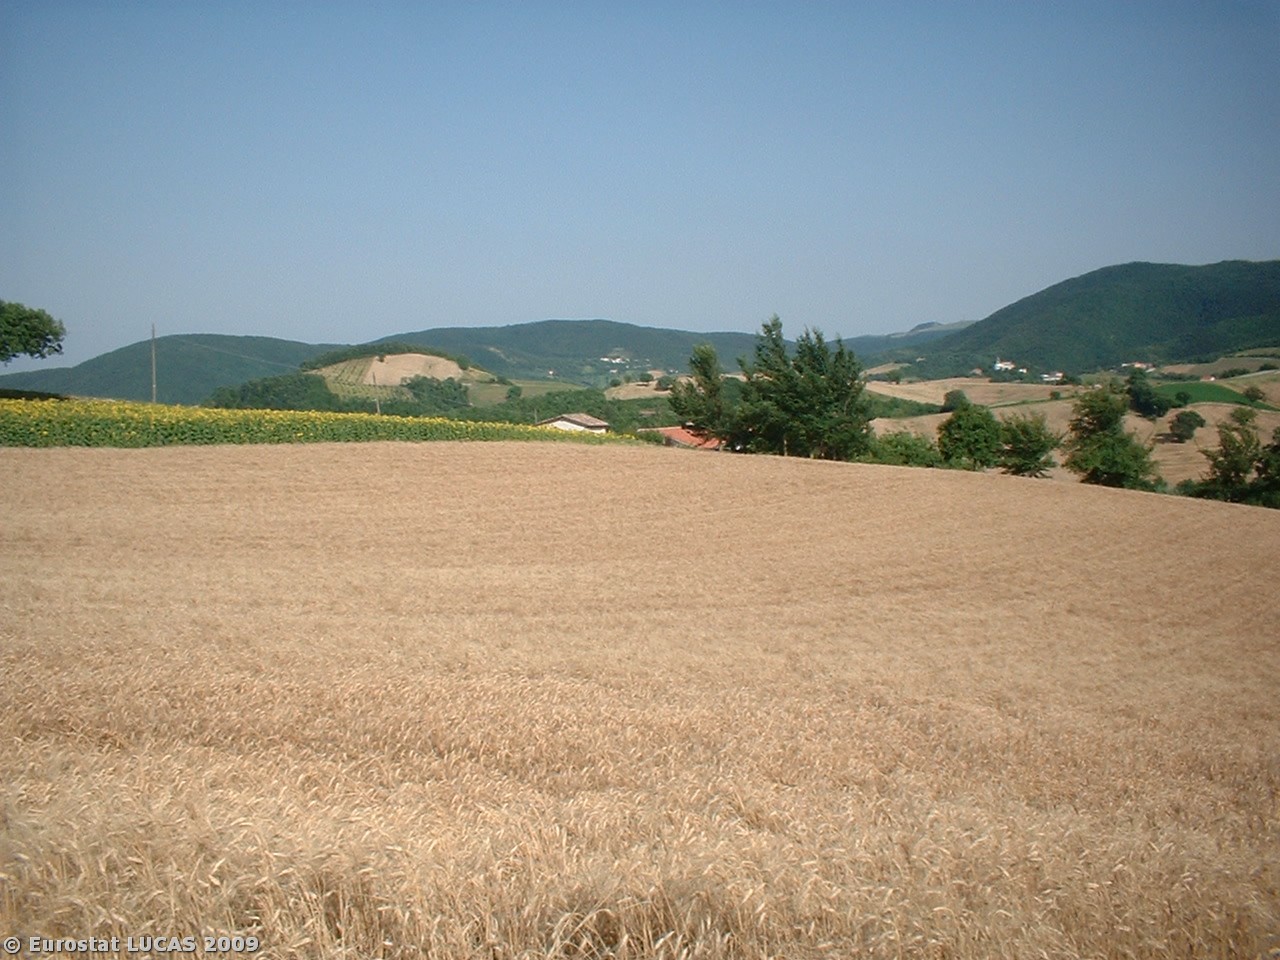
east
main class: Cropland
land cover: Durum wheat
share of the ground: > 75 %
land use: Agriculture (excluding fallow land and kitchen gardens)
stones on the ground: < 10 %
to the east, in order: Durum wheat; Sunflower; Grass margins; Lines of trees; Paved roads, cycling and walking lanes; Grass margins; Electric lines; Bare land; Grass margins; Fences; Grassland with sparse tree/shrub cover
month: July
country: IT
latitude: 43.4797
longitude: 12.8979
